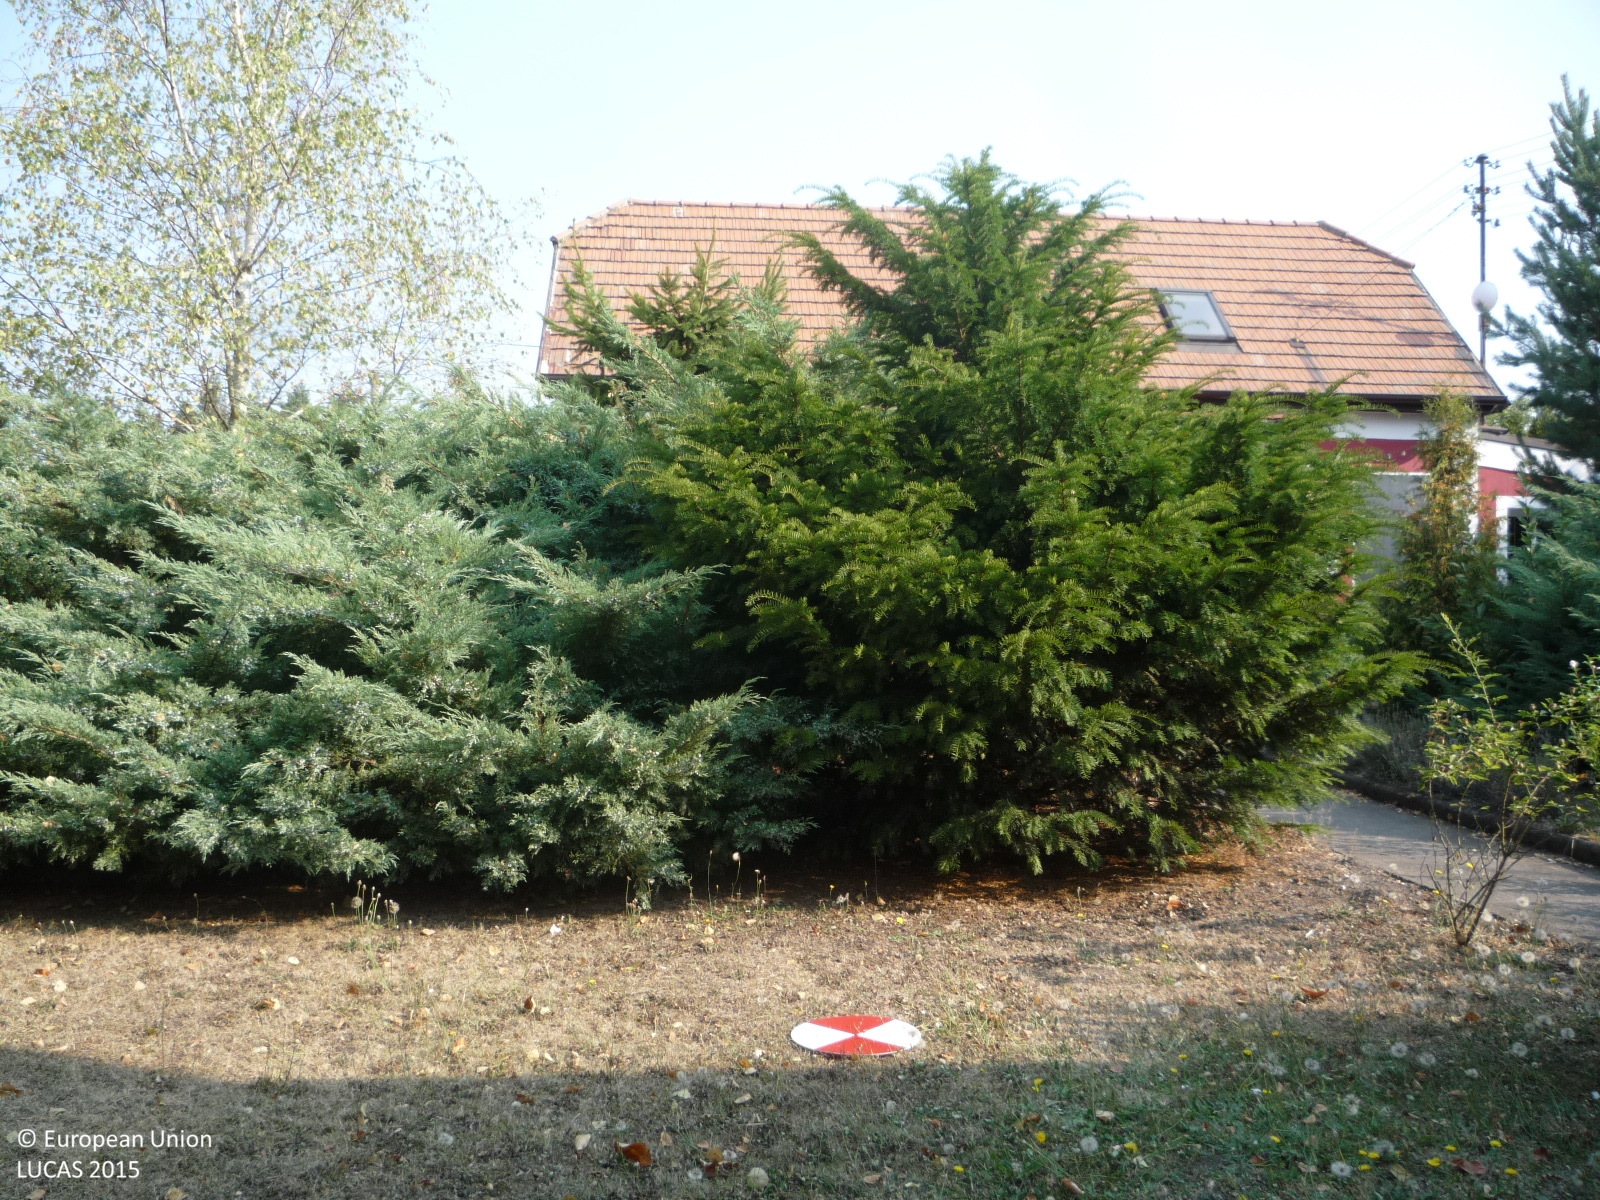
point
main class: Cropland
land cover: Apple fruit
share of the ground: 25 - 50 %
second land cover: Grassland without tree/shrub cover
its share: 50 - 75 %
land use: Kitchen garden
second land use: Amenities, museums, leisure
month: August
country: CZ
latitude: 49.9039
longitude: 14.3315
